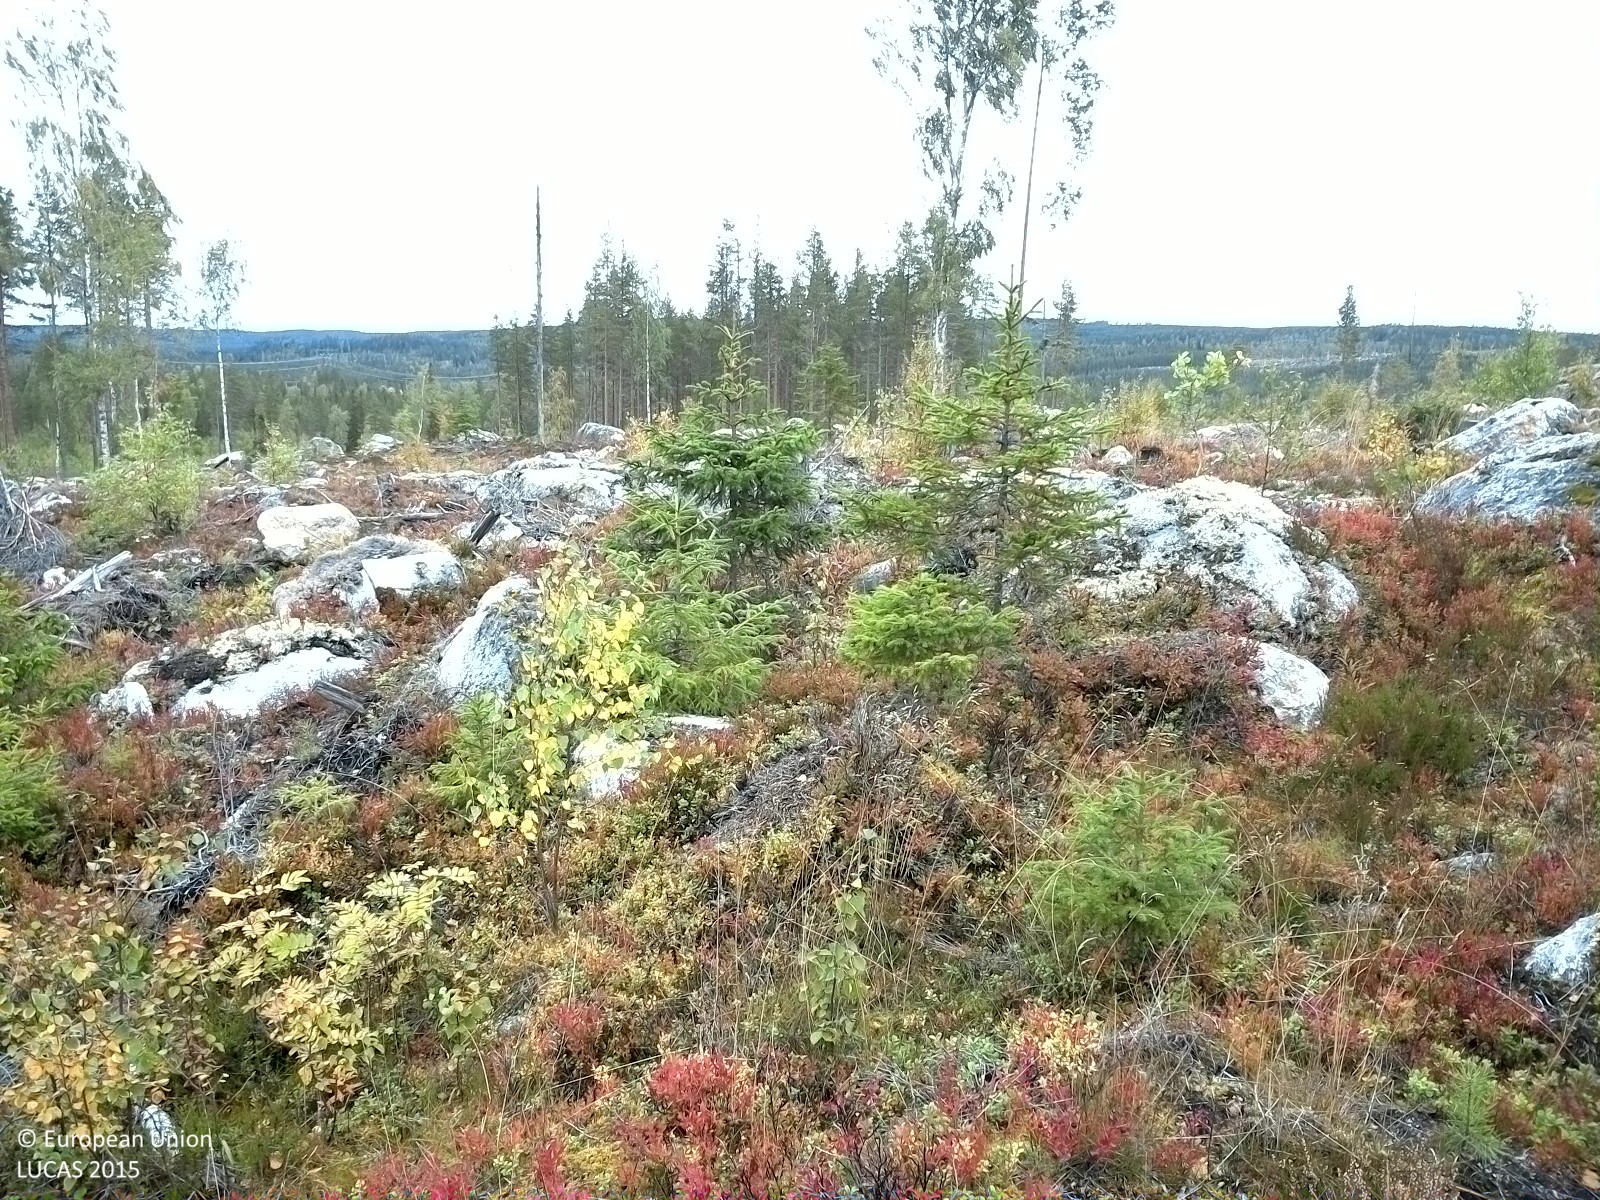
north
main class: Woodland
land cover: Spruce dominated mixed woodland
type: boreal forest
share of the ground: 10 - 25 %
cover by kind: shrubs 50 %, herbaceous plants 20 %, coniferous forest trees 10 %, broadleaved forest trees 10 %, lichens and mosses 10 %
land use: Forestry
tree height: < 5 m
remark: Clear cut
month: September
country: SE
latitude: 62.2378
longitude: 15.5808
